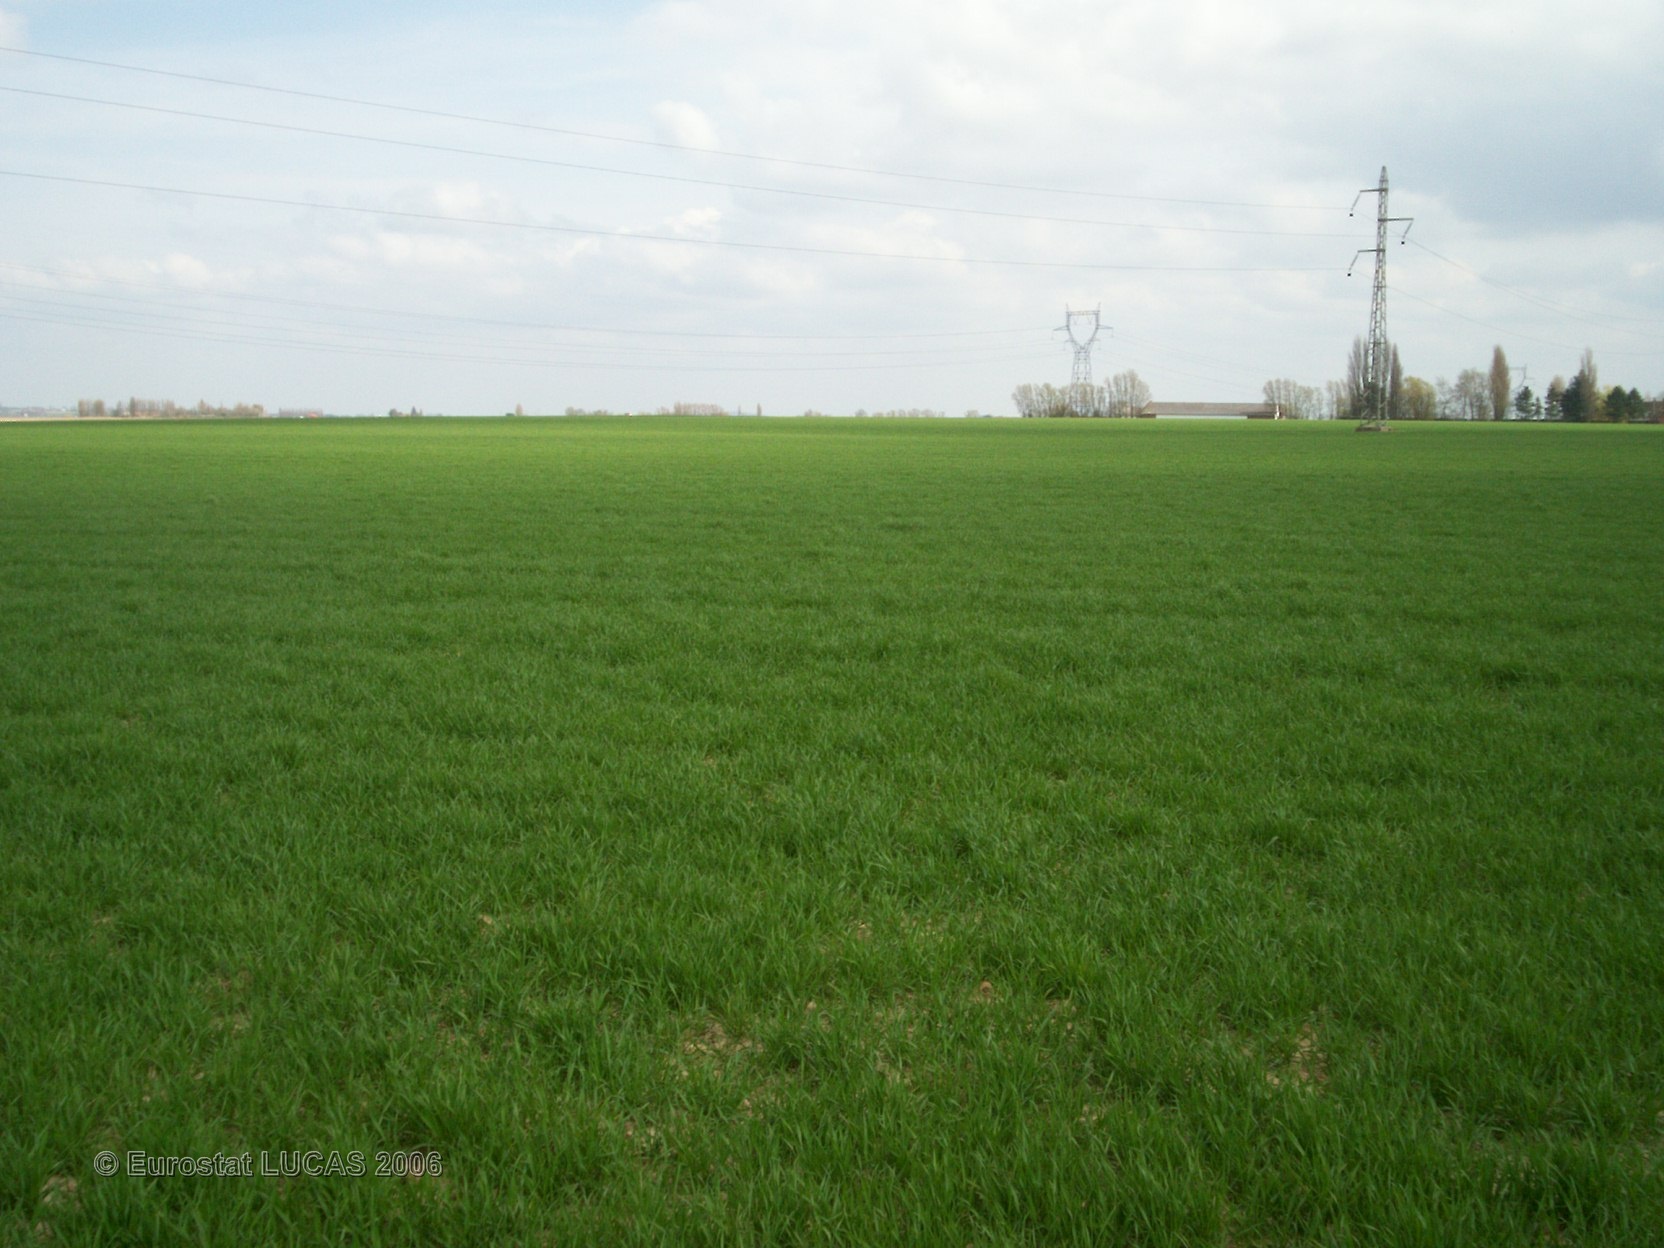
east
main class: Cropland
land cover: Common wheat
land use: Agriculture (excluding fallow land and kitchen gardens)
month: April
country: FR
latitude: 50.7632
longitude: 2.4302
